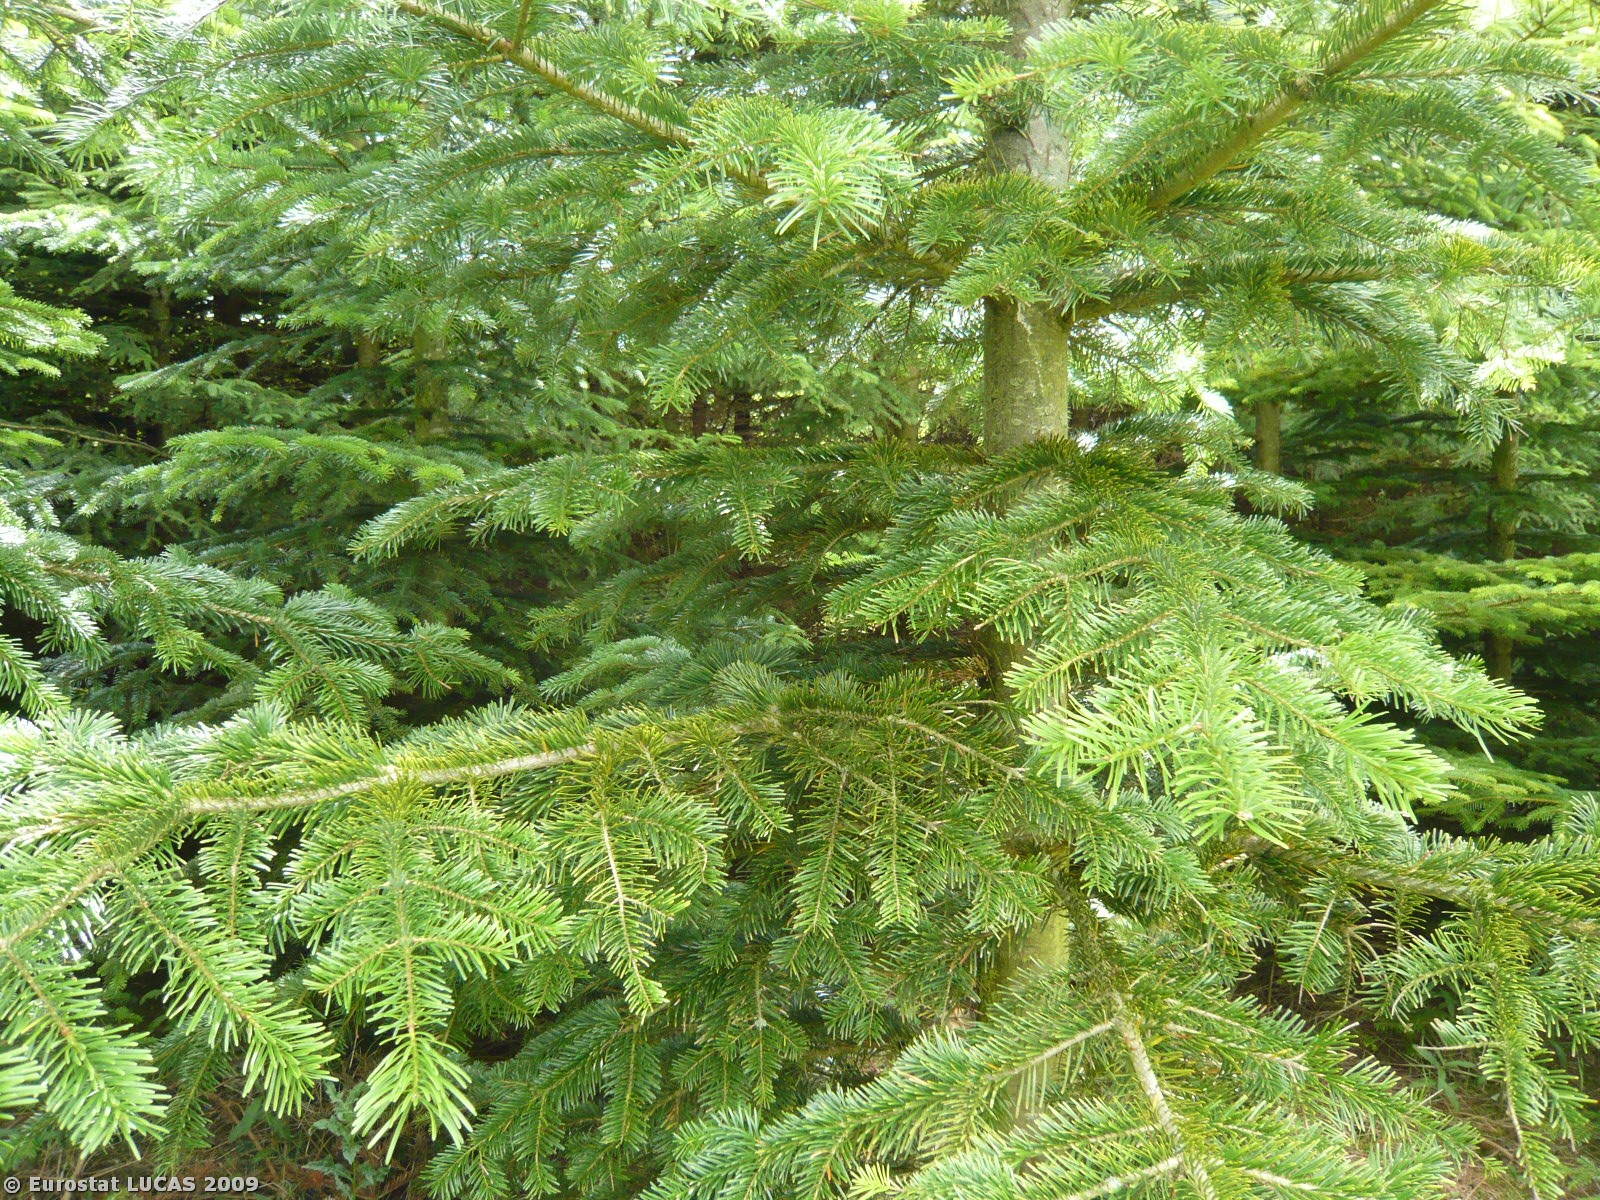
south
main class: Cropland
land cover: Cherry fruit
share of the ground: > 75 %
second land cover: Spontaneously vegetated surfaces
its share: 10 - 25 %
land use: Agriculture (excluding fallow land and kitchen gardens)
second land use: Fallow land
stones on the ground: < 10 %
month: July
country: DK
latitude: 55.4851
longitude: 10.6482
